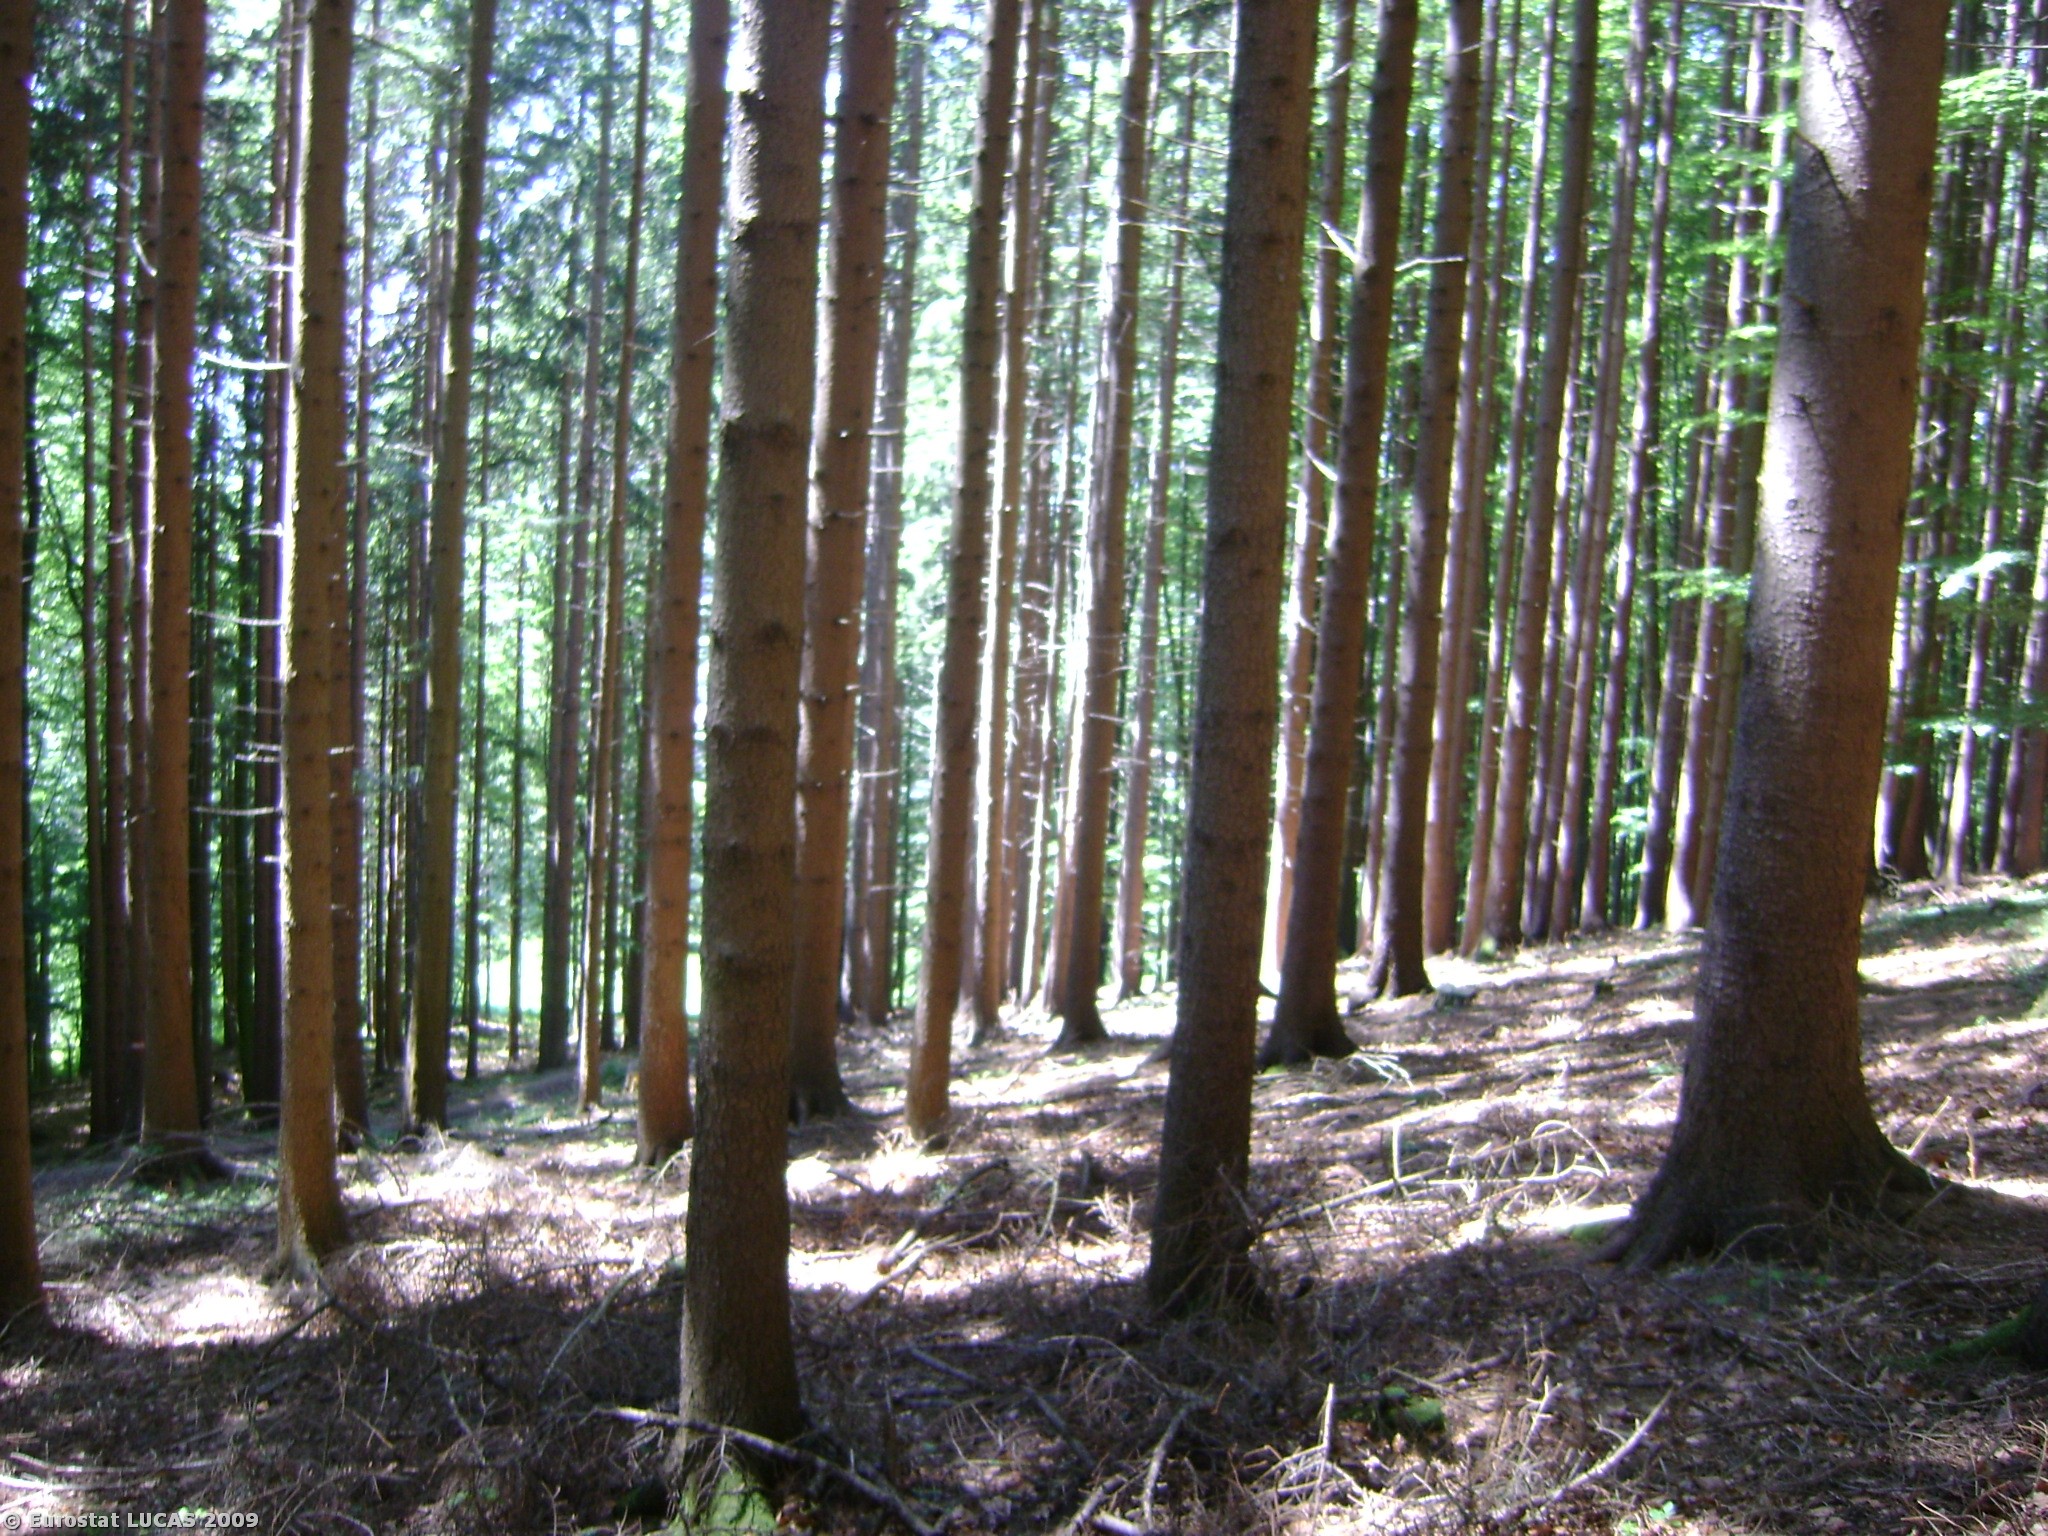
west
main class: Woodland
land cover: Coniferous woodland
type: hemiboreal forest and nemoral coniferous forest and mixed broadleaved-coniferous forest
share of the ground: > 75 %
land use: Forestry
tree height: > 5 m
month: May
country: AT
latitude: 47.9332
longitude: 13.5193
